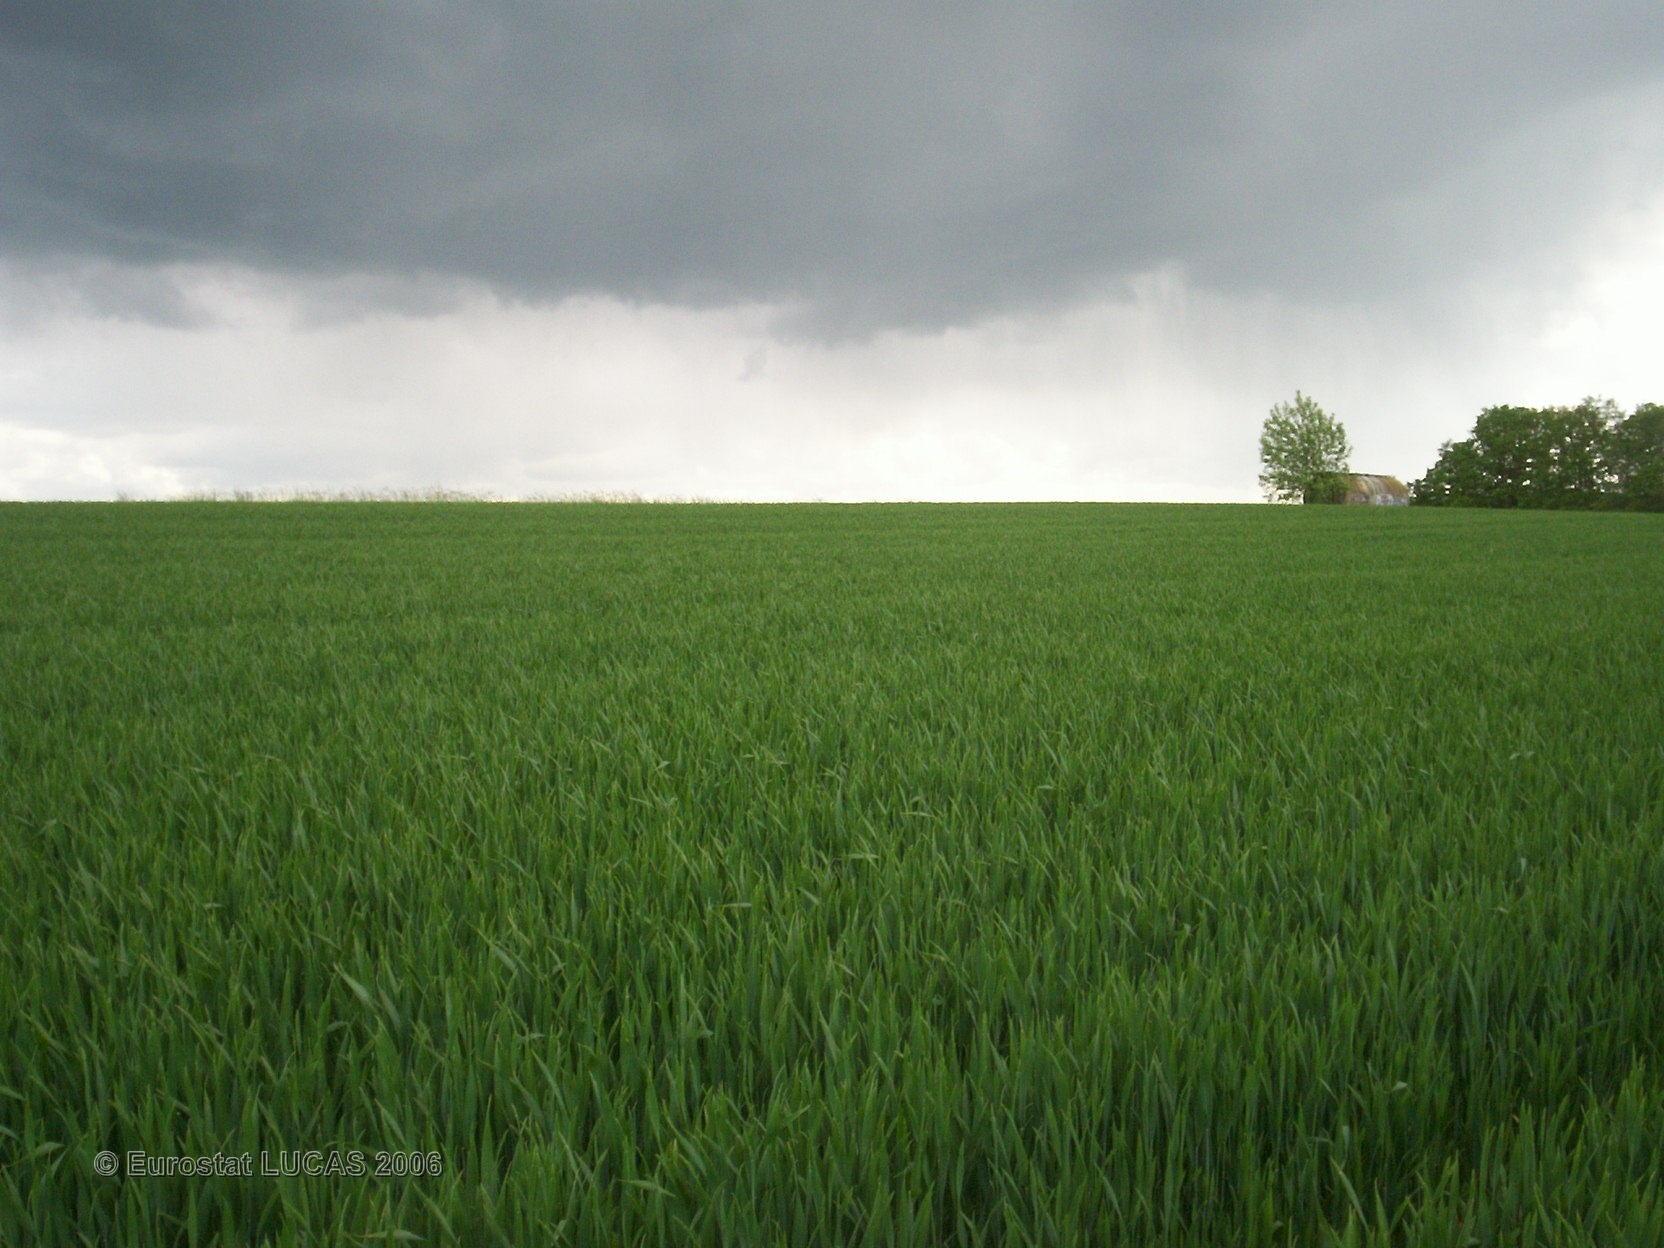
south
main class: Cropland
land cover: Common wheat
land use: Agriculture (excluding fallow land and kitchen gardens)
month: May
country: FR
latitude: 49.4424
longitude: 4.5764
